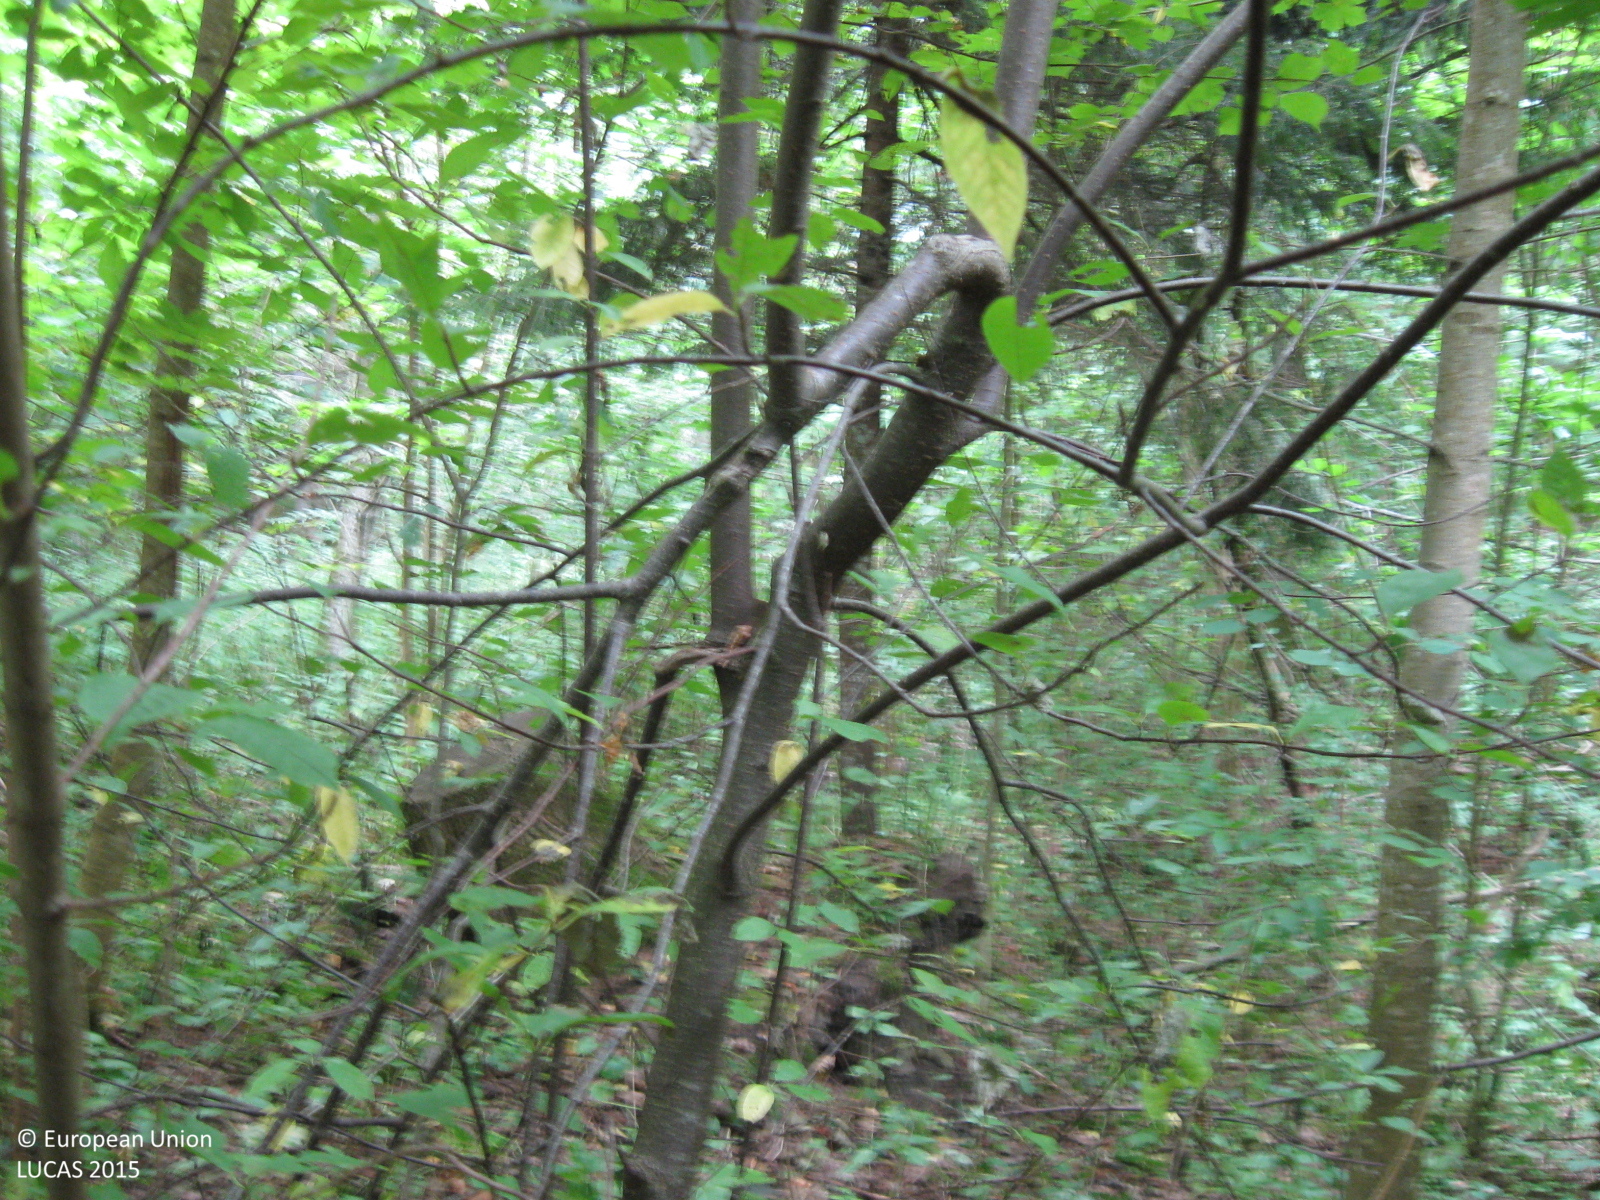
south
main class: Woodland
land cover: Other mixed woodland
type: hemiboreal forest and nemoral coniferous forest and mixed broadleaved-coniferous forest
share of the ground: > 75 %
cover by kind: broadleaved forest trees 55 %, coniferous forest trees 45 %
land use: Forestry
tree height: > 5 m
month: August
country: LT
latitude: 55.1520
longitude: 23.4011
